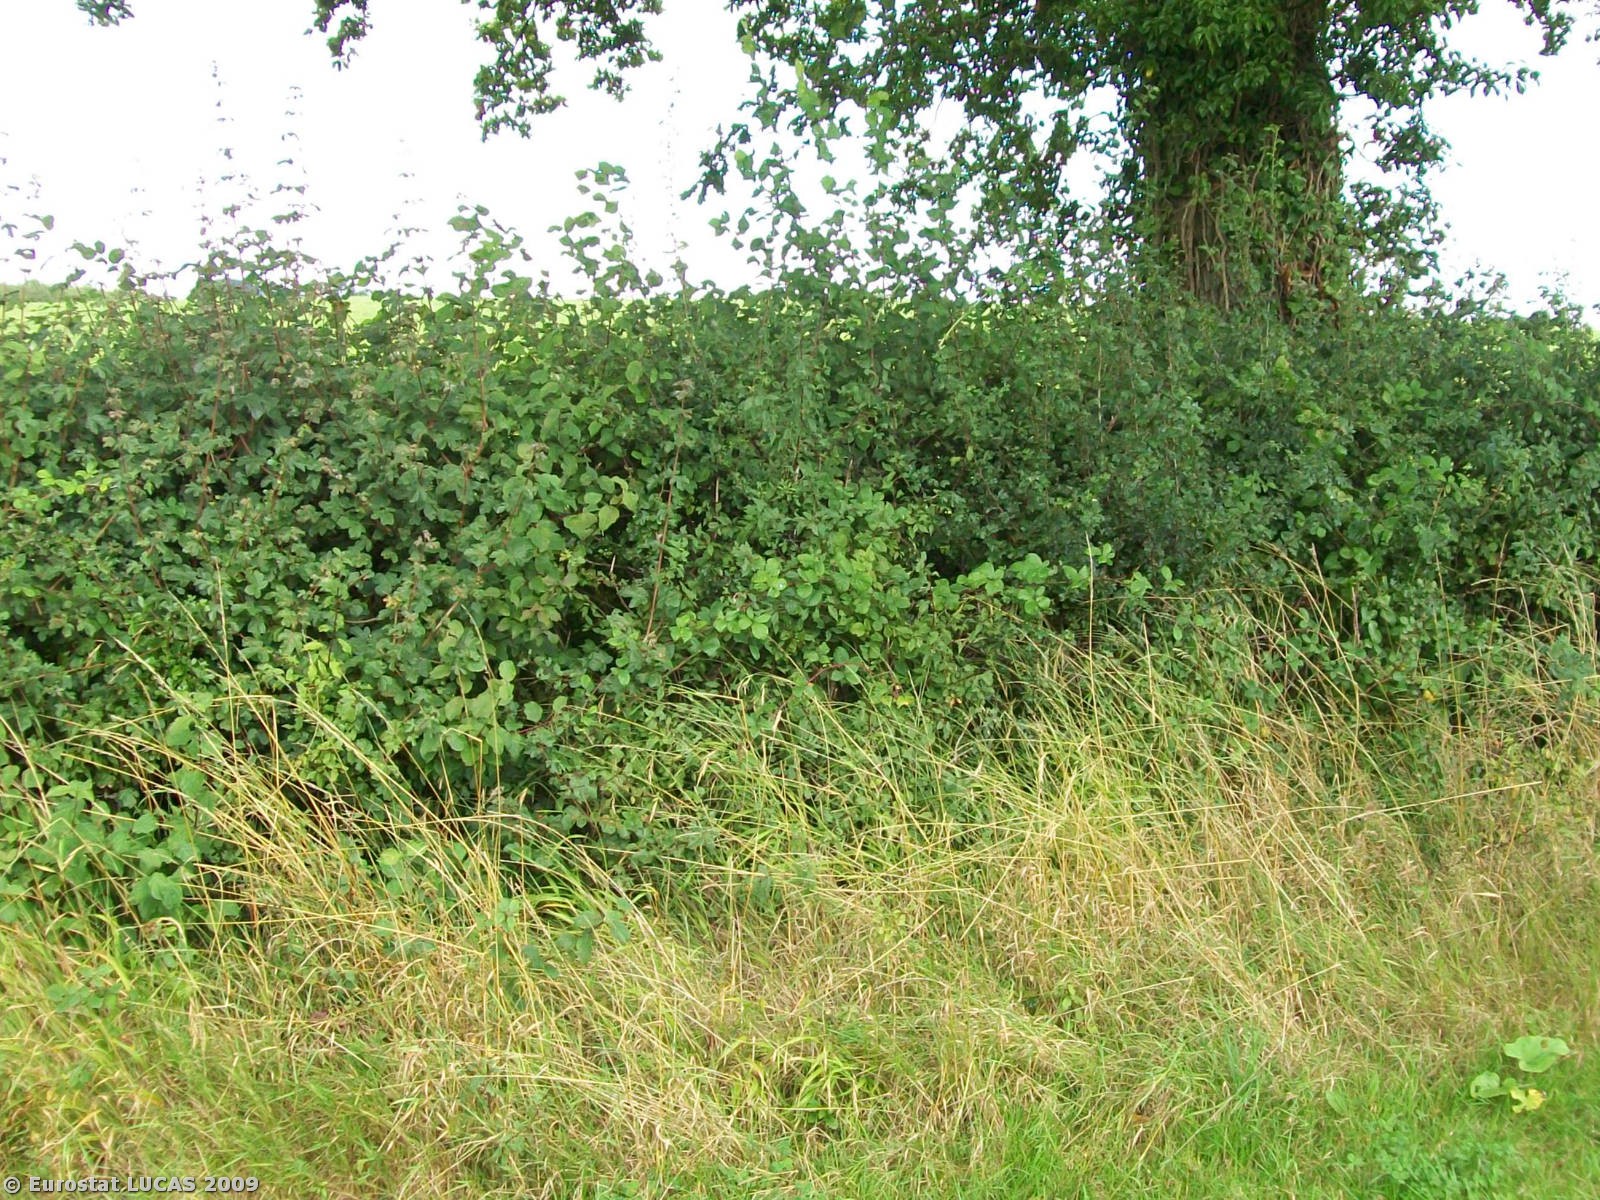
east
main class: Grassland
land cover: Grassland without tree/shrub cover
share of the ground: > 75 %
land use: Agriculture (excluding fallow land and kitchen gardens)
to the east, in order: Grassland without tree/shrub cover; Managed hedges; Ditches and canals; Grassland without tree/shrub cover; Fences; Grassland without tree/shrub cover
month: August
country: GB
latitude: 51.7965
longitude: -2.4044
